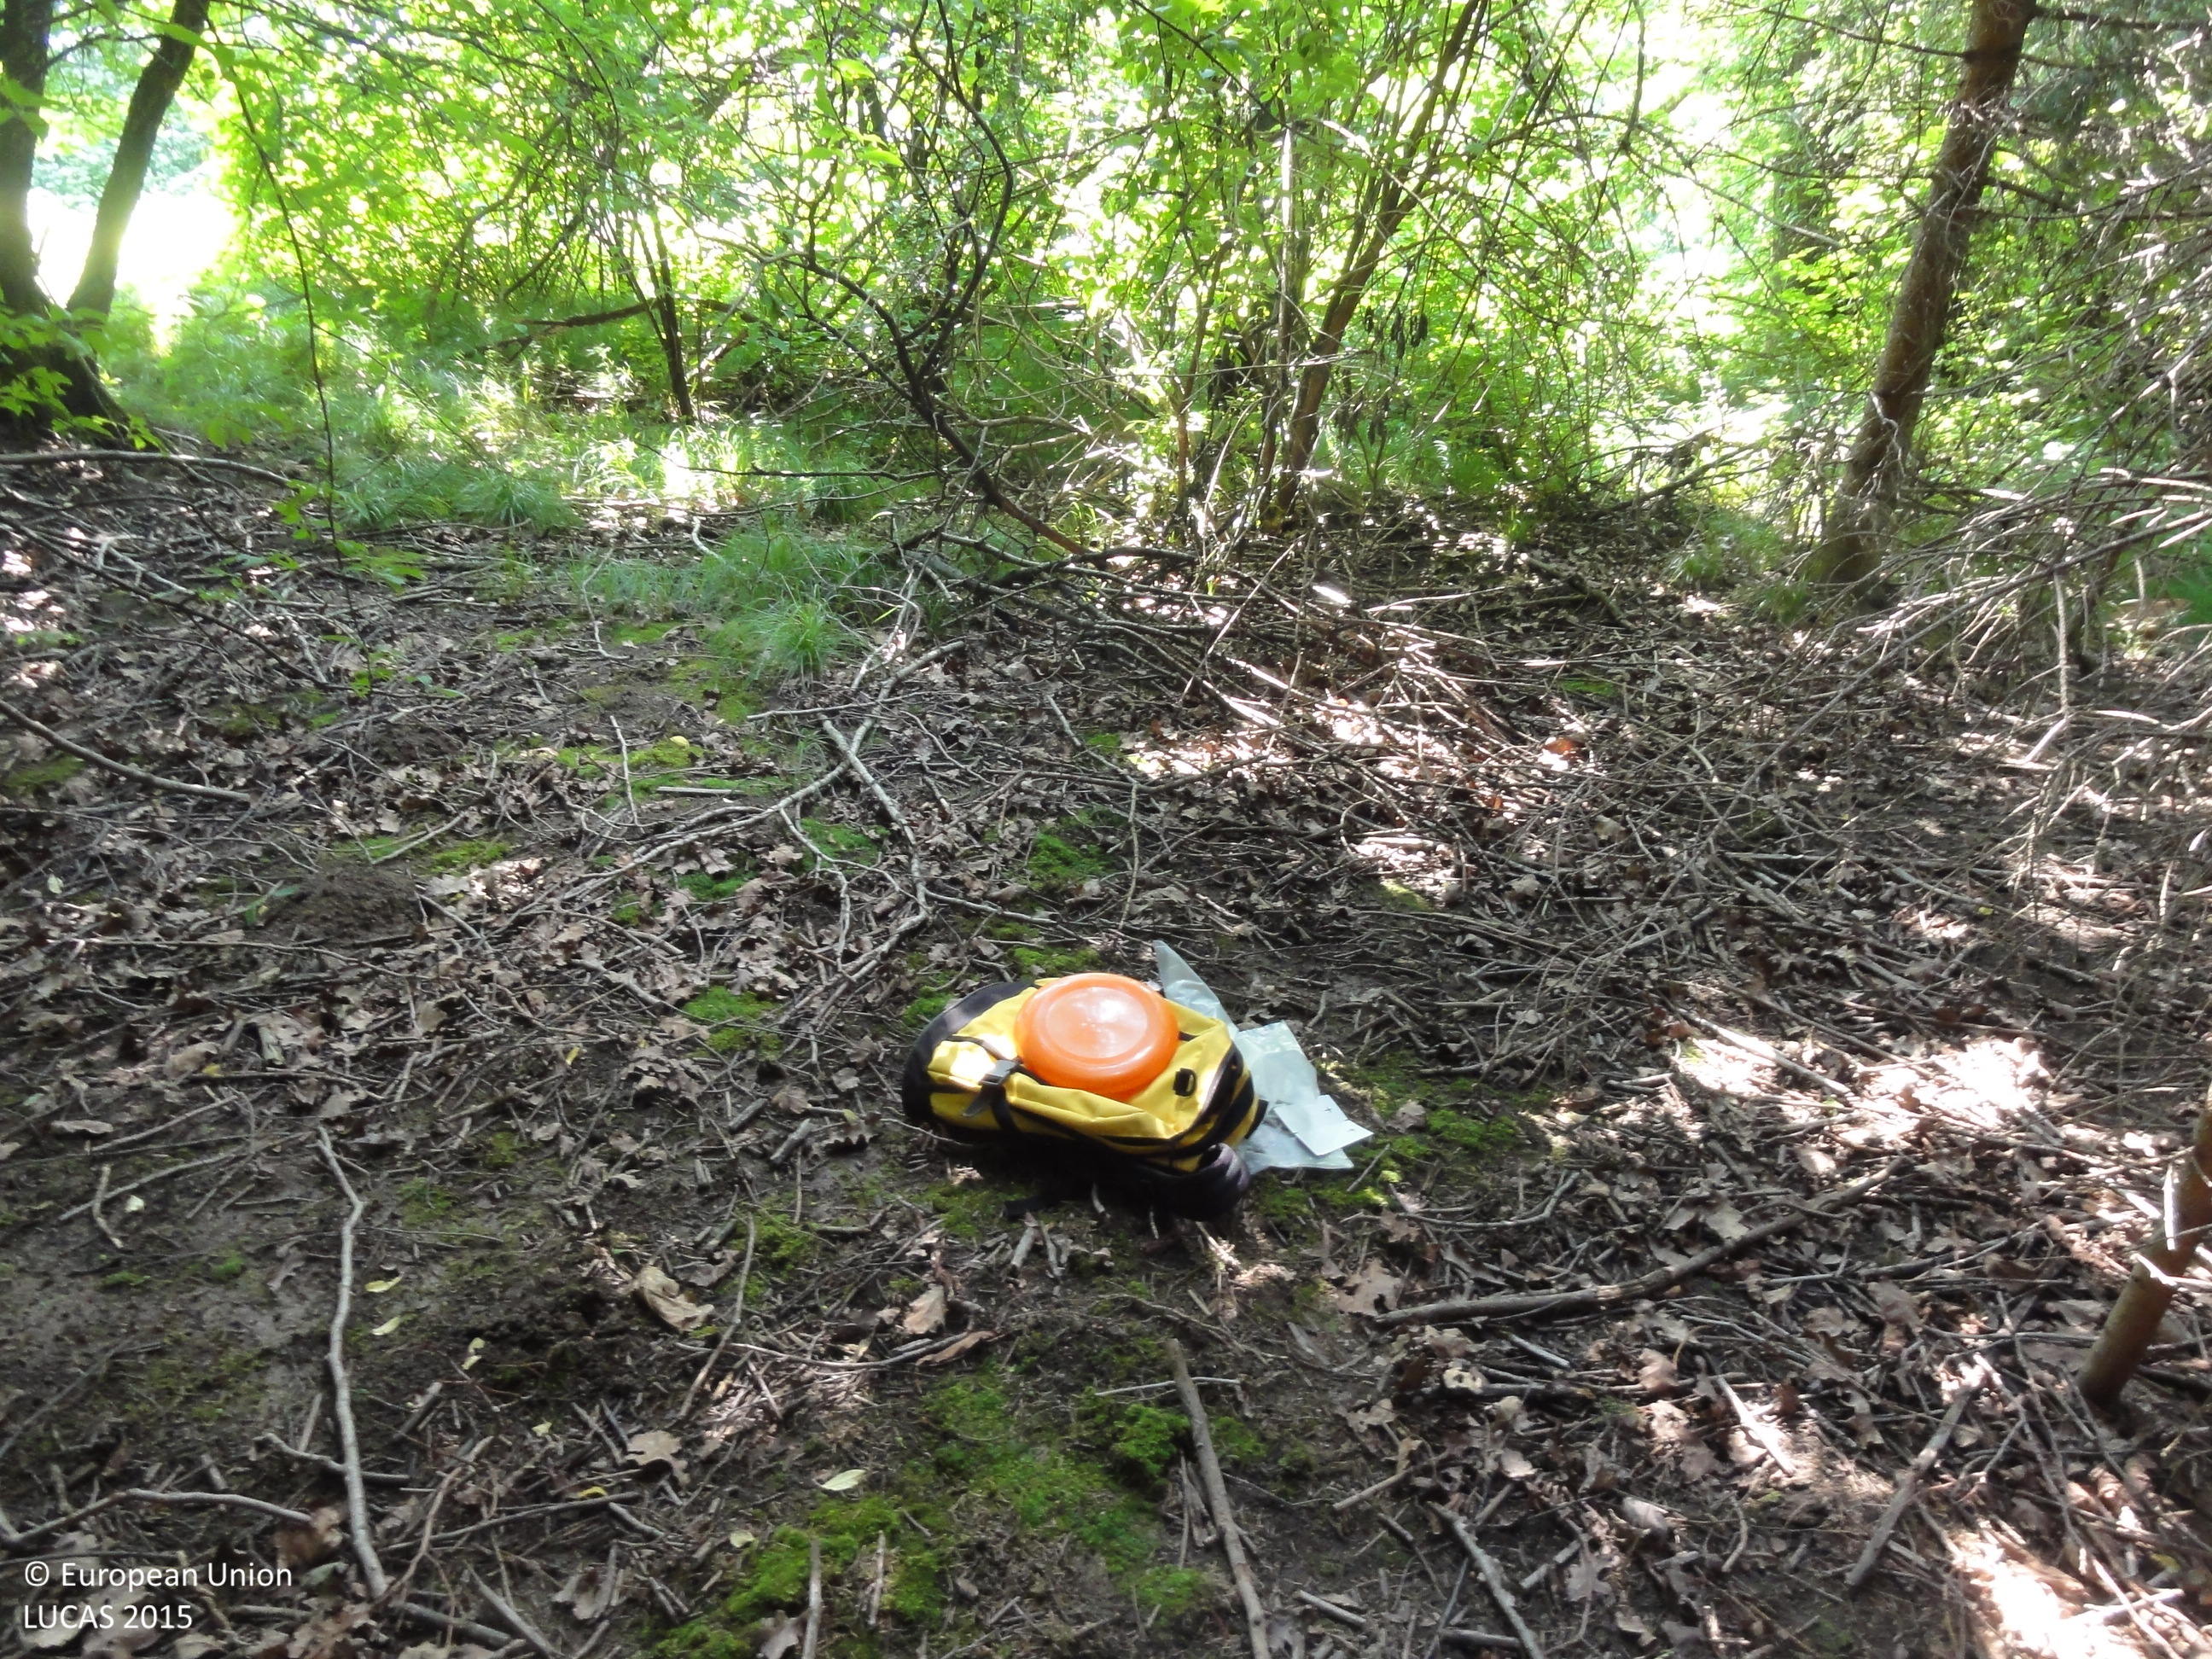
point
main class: Woodland
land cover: Spruce dominated mixed woodland
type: hemiboreal forest and nemoral coniferous forest and mixed broadleaved-coniferous forest
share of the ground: > 75 %
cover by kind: coniferous forest trees 75 %, broadleaved forest trees 25 %
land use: Forestry
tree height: > 5 m
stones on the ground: < 10 %
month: June
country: SI
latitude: 46.3794
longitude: 15.7065
